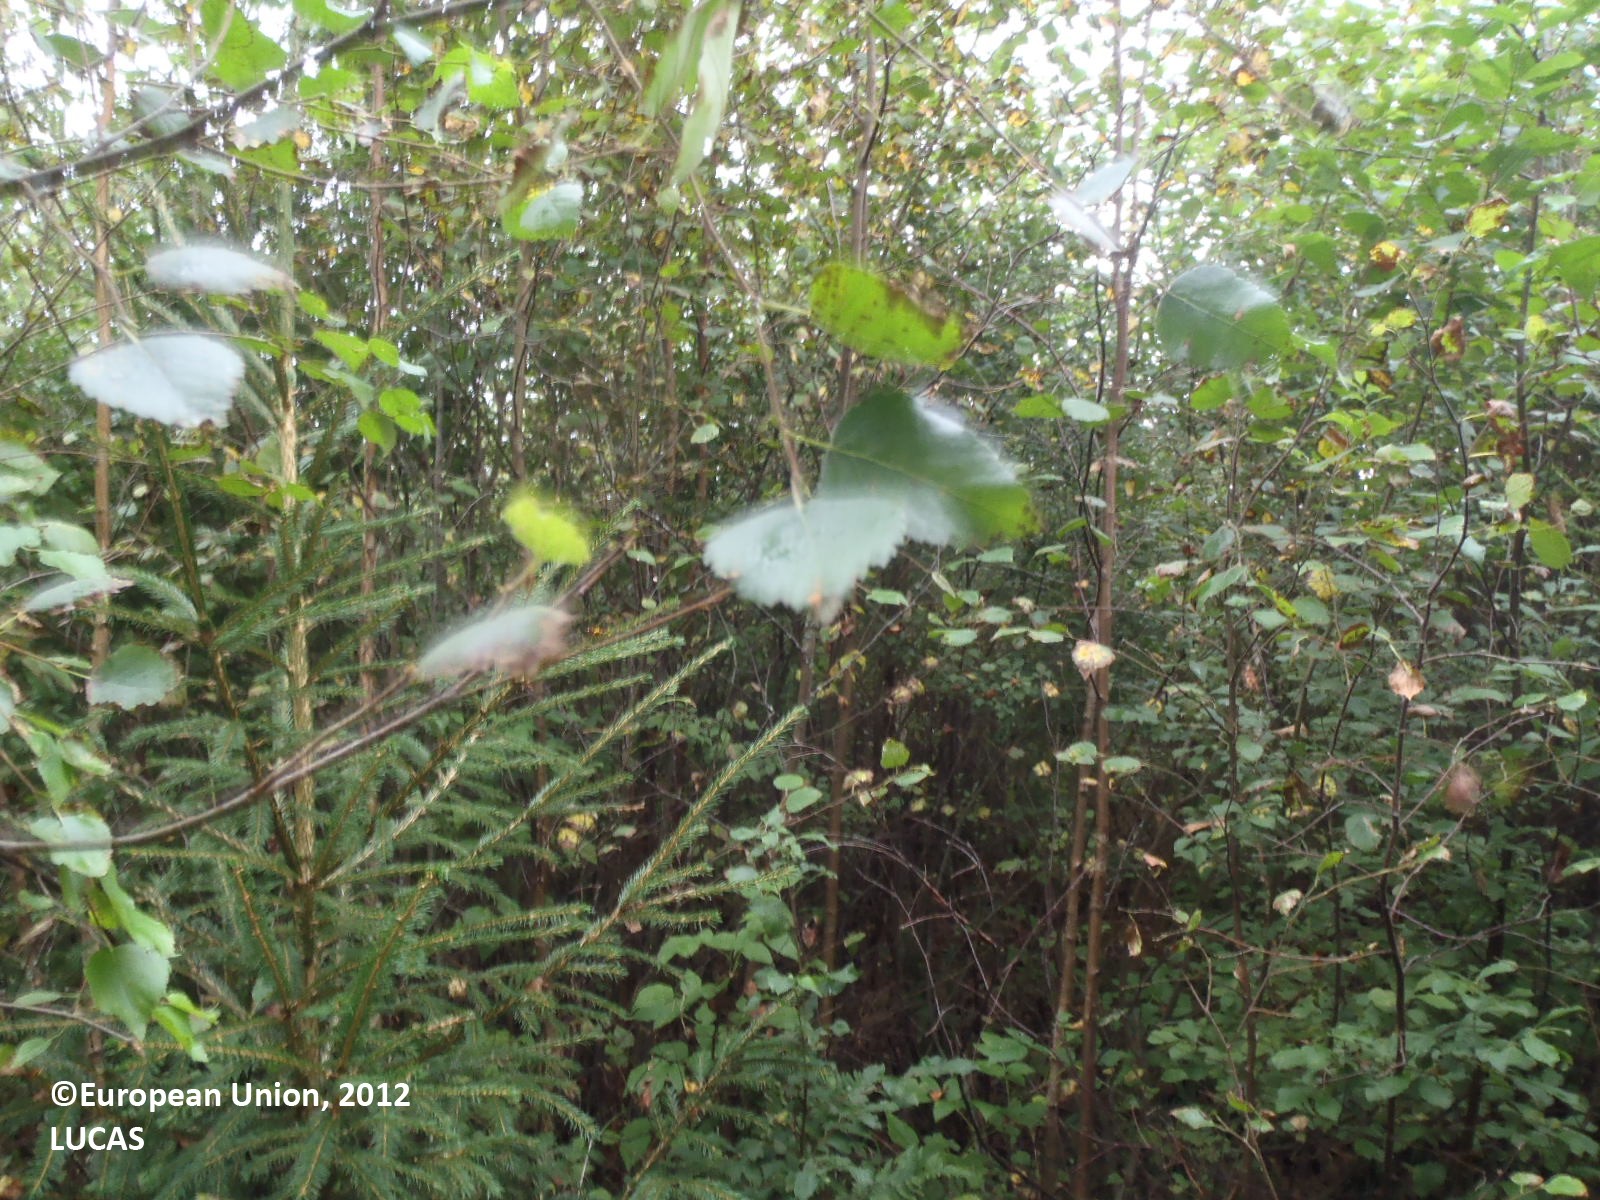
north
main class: Woodland
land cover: Broadleaved woodland
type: boreal forest
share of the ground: > 75 %
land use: Forestry
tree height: > 5 m
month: August
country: FI
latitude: 60.5971
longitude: 22.2083
